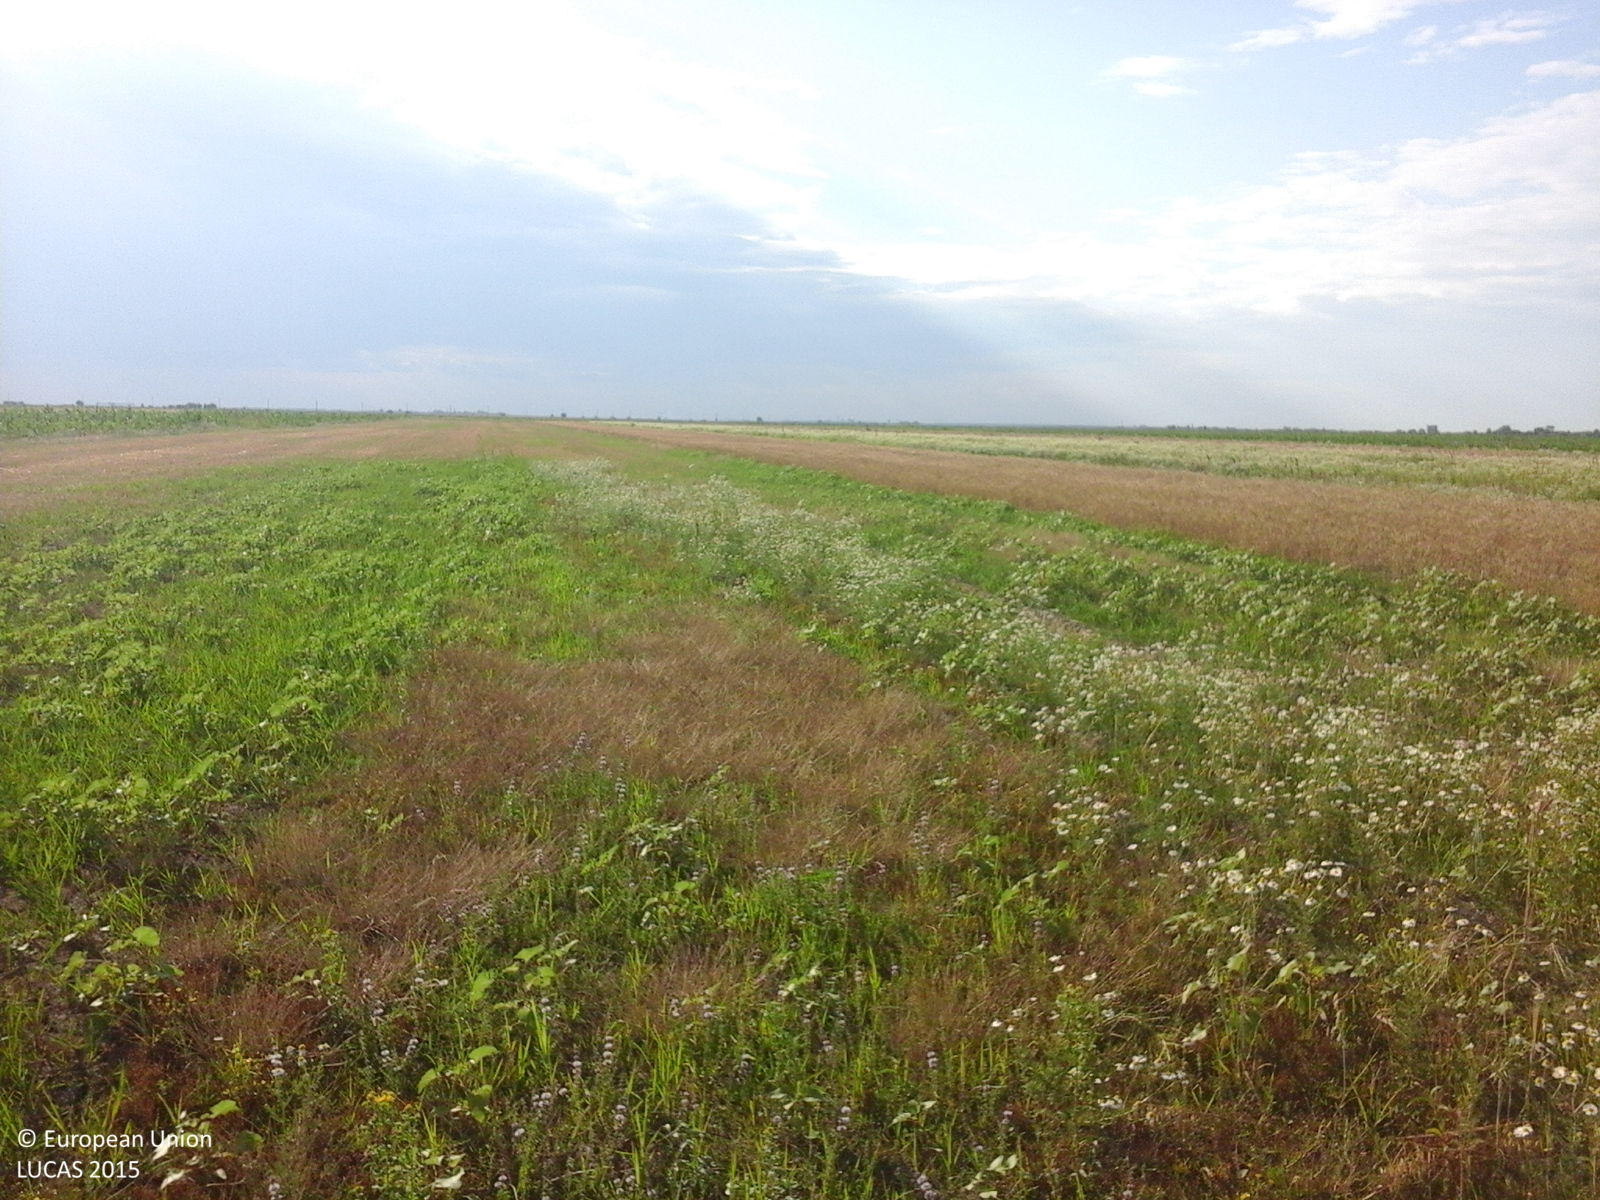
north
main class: Grassland
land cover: Spontaneously vegetated surfaces
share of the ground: < 10 %
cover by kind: herbaceous plants 100 %
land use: Fallow land
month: July
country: RO
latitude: 44.4138
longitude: 25.4489
